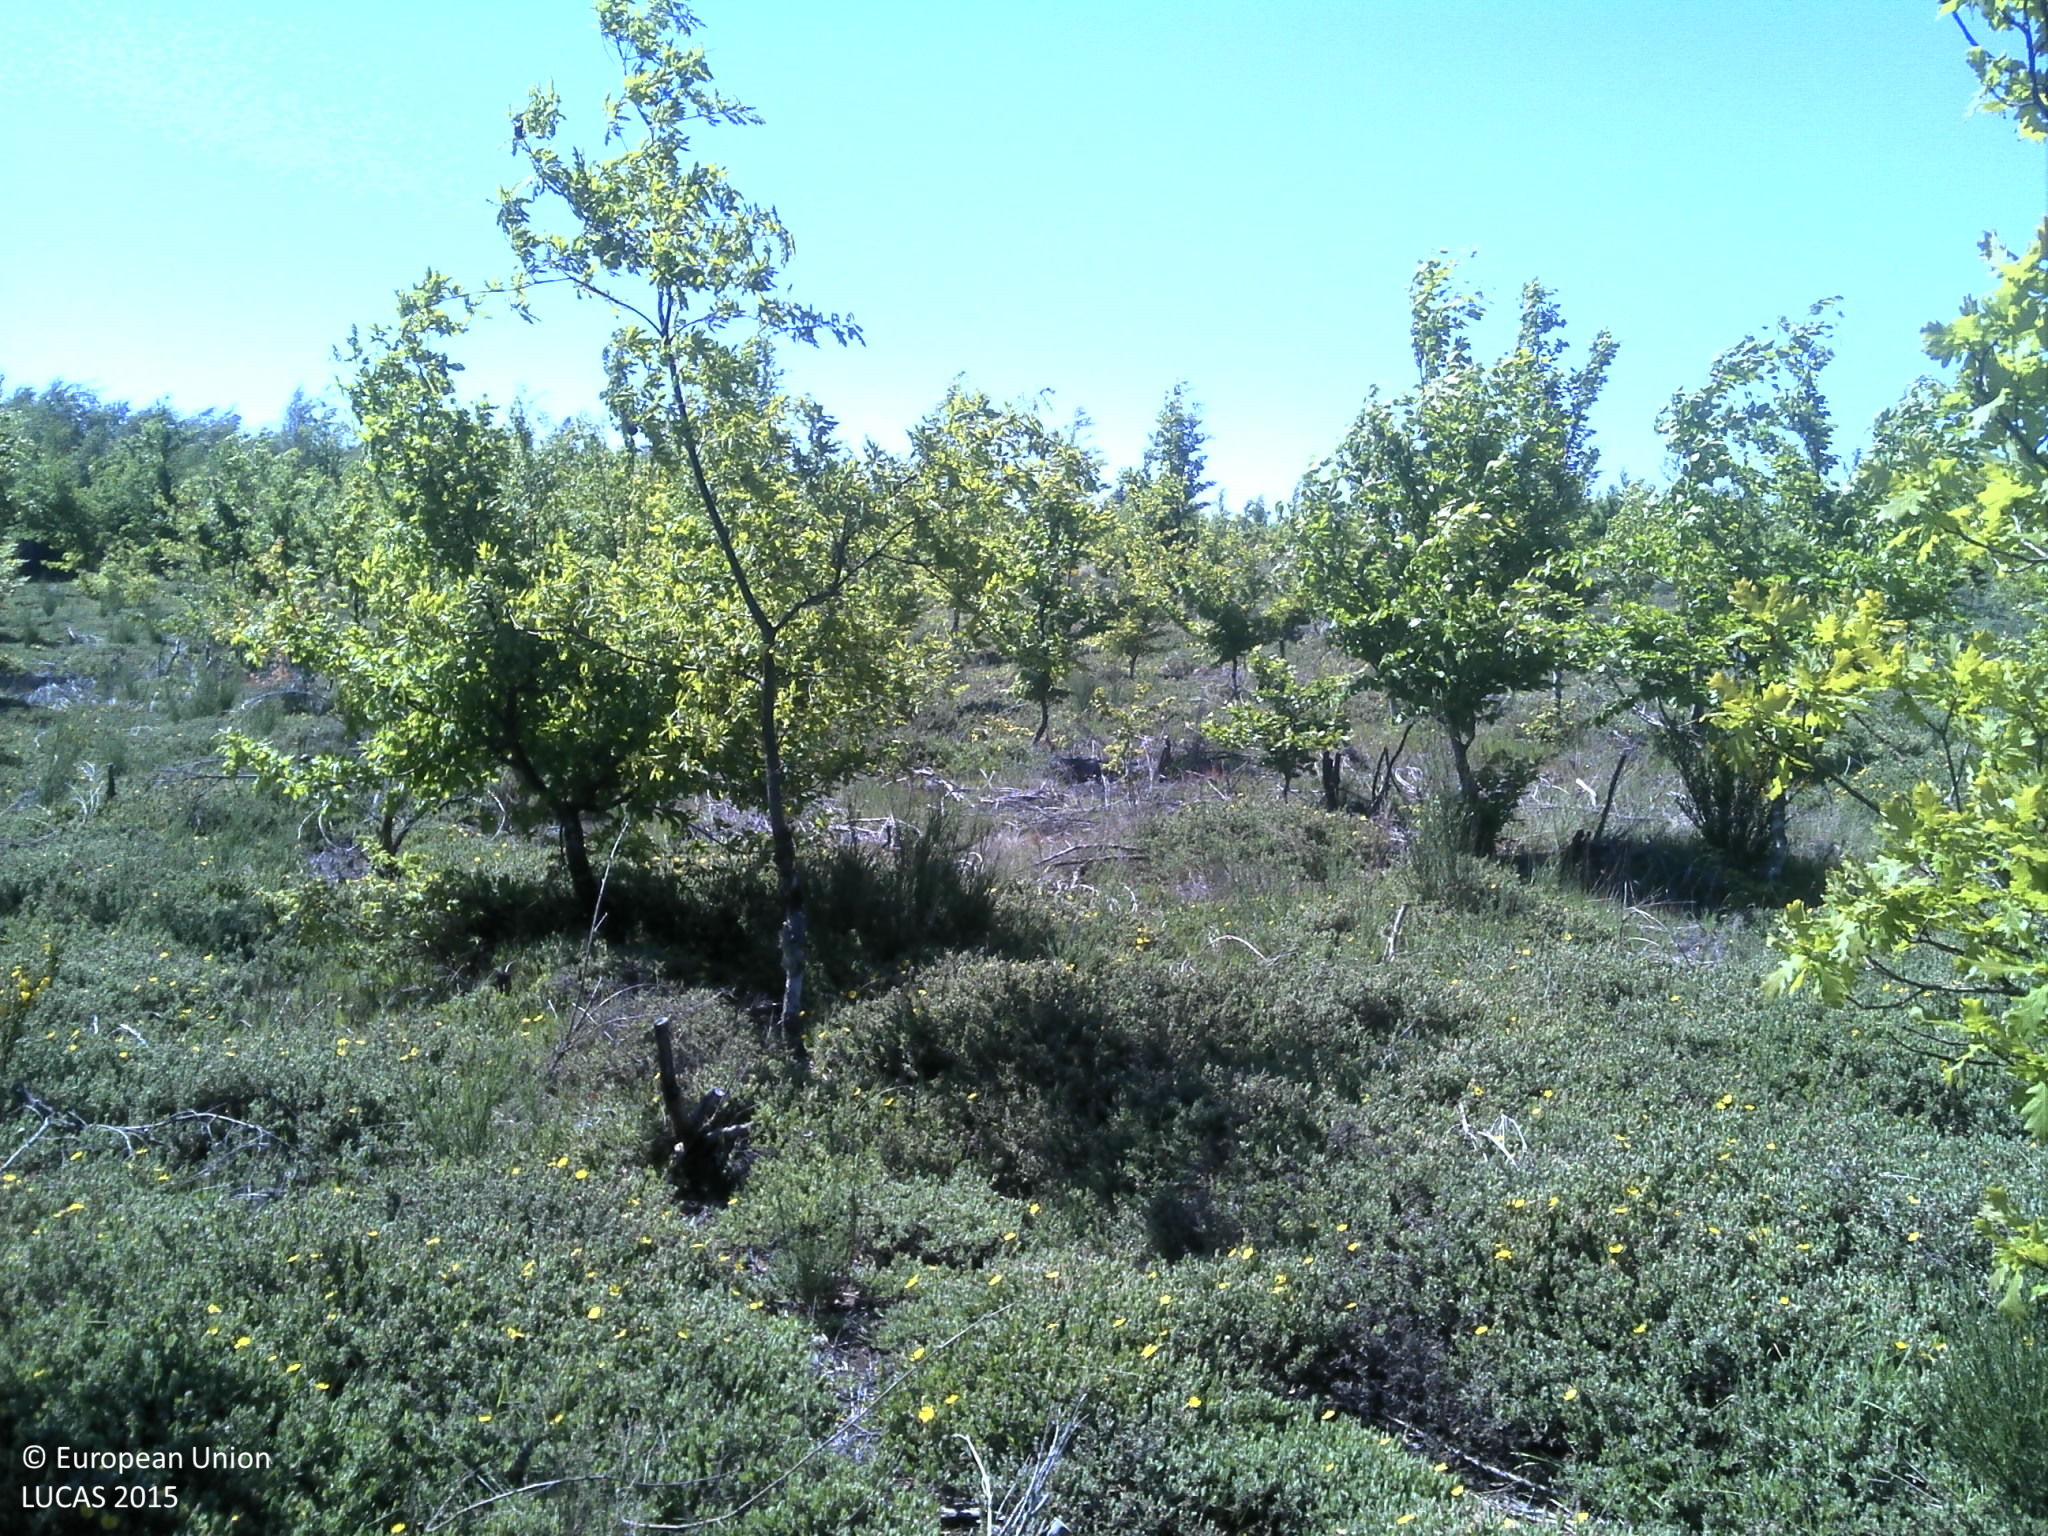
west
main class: Woodland
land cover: Broadleaved woodland
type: mesophytic deciduous forest
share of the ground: 25 - 50 %
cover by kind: broadleaved forest trees 45 %, shrubs 25 %, herbaceous plants 25 %
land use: Forestry
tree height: > 5 m
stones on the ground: 10 - 25 %
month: May
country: PT
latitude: 40.5212
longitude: -7.4252
